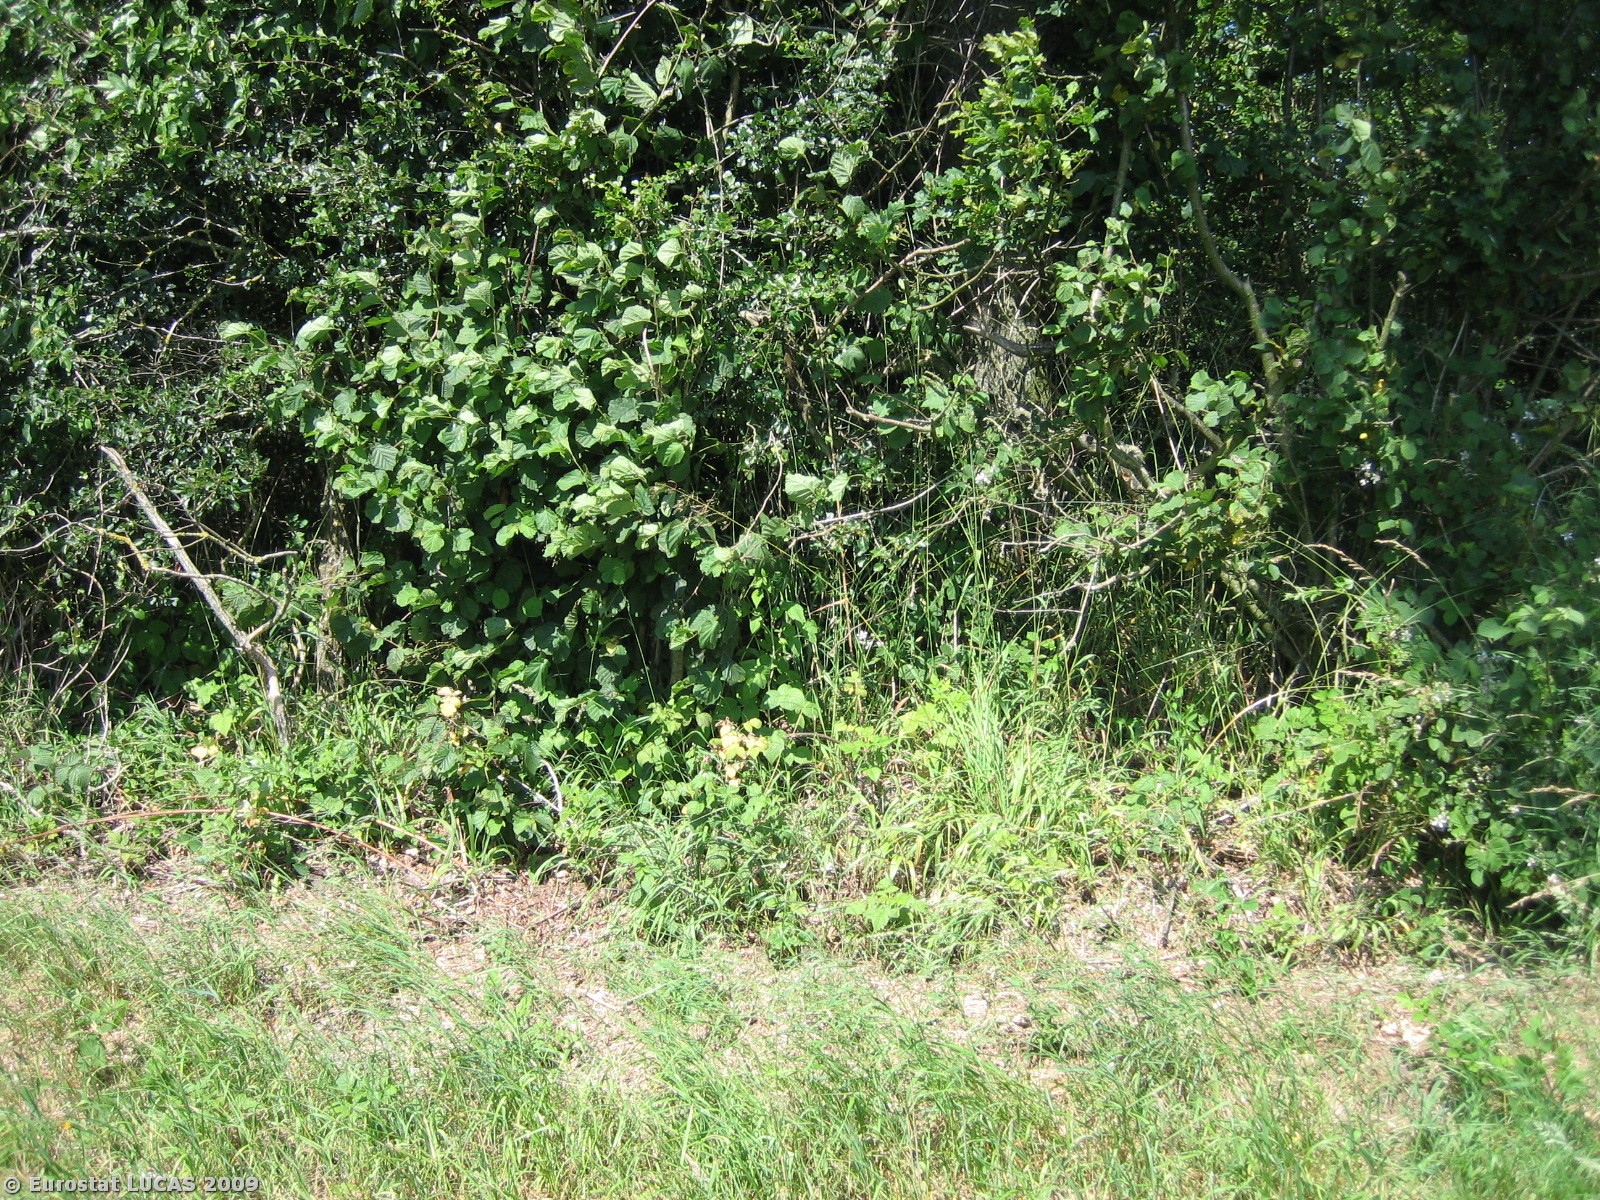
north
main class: Woodland
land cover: Coniferous woodland
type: hemiboreal forest and nemoral coniferous forest and mixed broadleaved-coniferous forest
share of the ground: 50 - 75 %
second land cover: Spontaneously vegetated surfaces
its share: 25 - 50 %
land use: Forestry
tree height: > 5 m
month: July
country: DK
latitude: 55.3589
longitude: 9.2908
